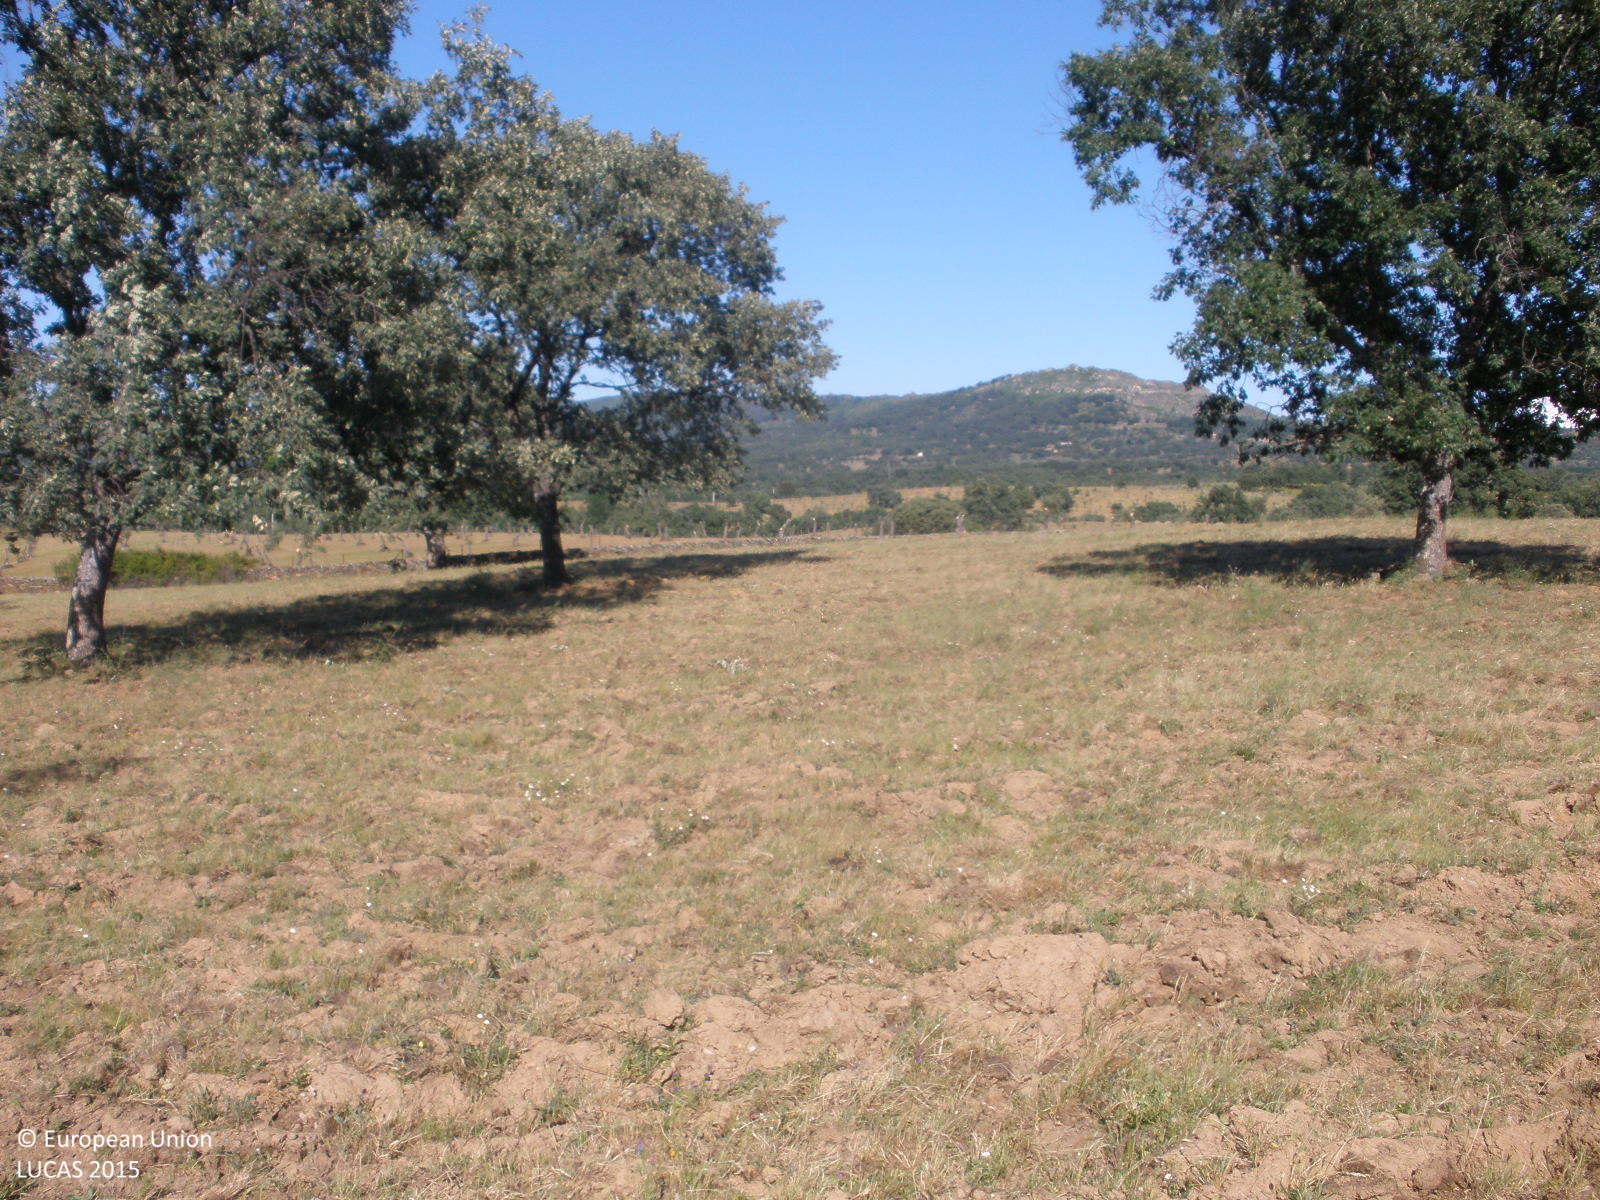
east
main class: Woodland
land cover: Broadleaved woodland
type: broadleaved evergreen forest
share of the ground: 25 - 50 %
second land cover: Spontaneously vegetated surfaces
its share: > 75 %
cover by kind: herbaceous plants 60 %, broadleaved forest trees 30 %, consolidated bare surface 10 %
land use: Forestry
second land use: Agriculture (excluding fallow land and kitchen gardens)
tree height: > 5 m
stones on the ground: 10 - 25 %
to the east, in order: Broadleaved woodland; Spontaneously vegetated surfaces; Tracks; Grassland without tree/shrub cover; Dry stone walls; Fences; Olive groves; Spontaneously vegetated surfaces; Ponds and wetlands
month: May
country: ES
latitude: 40.1279
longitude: -6.8350
